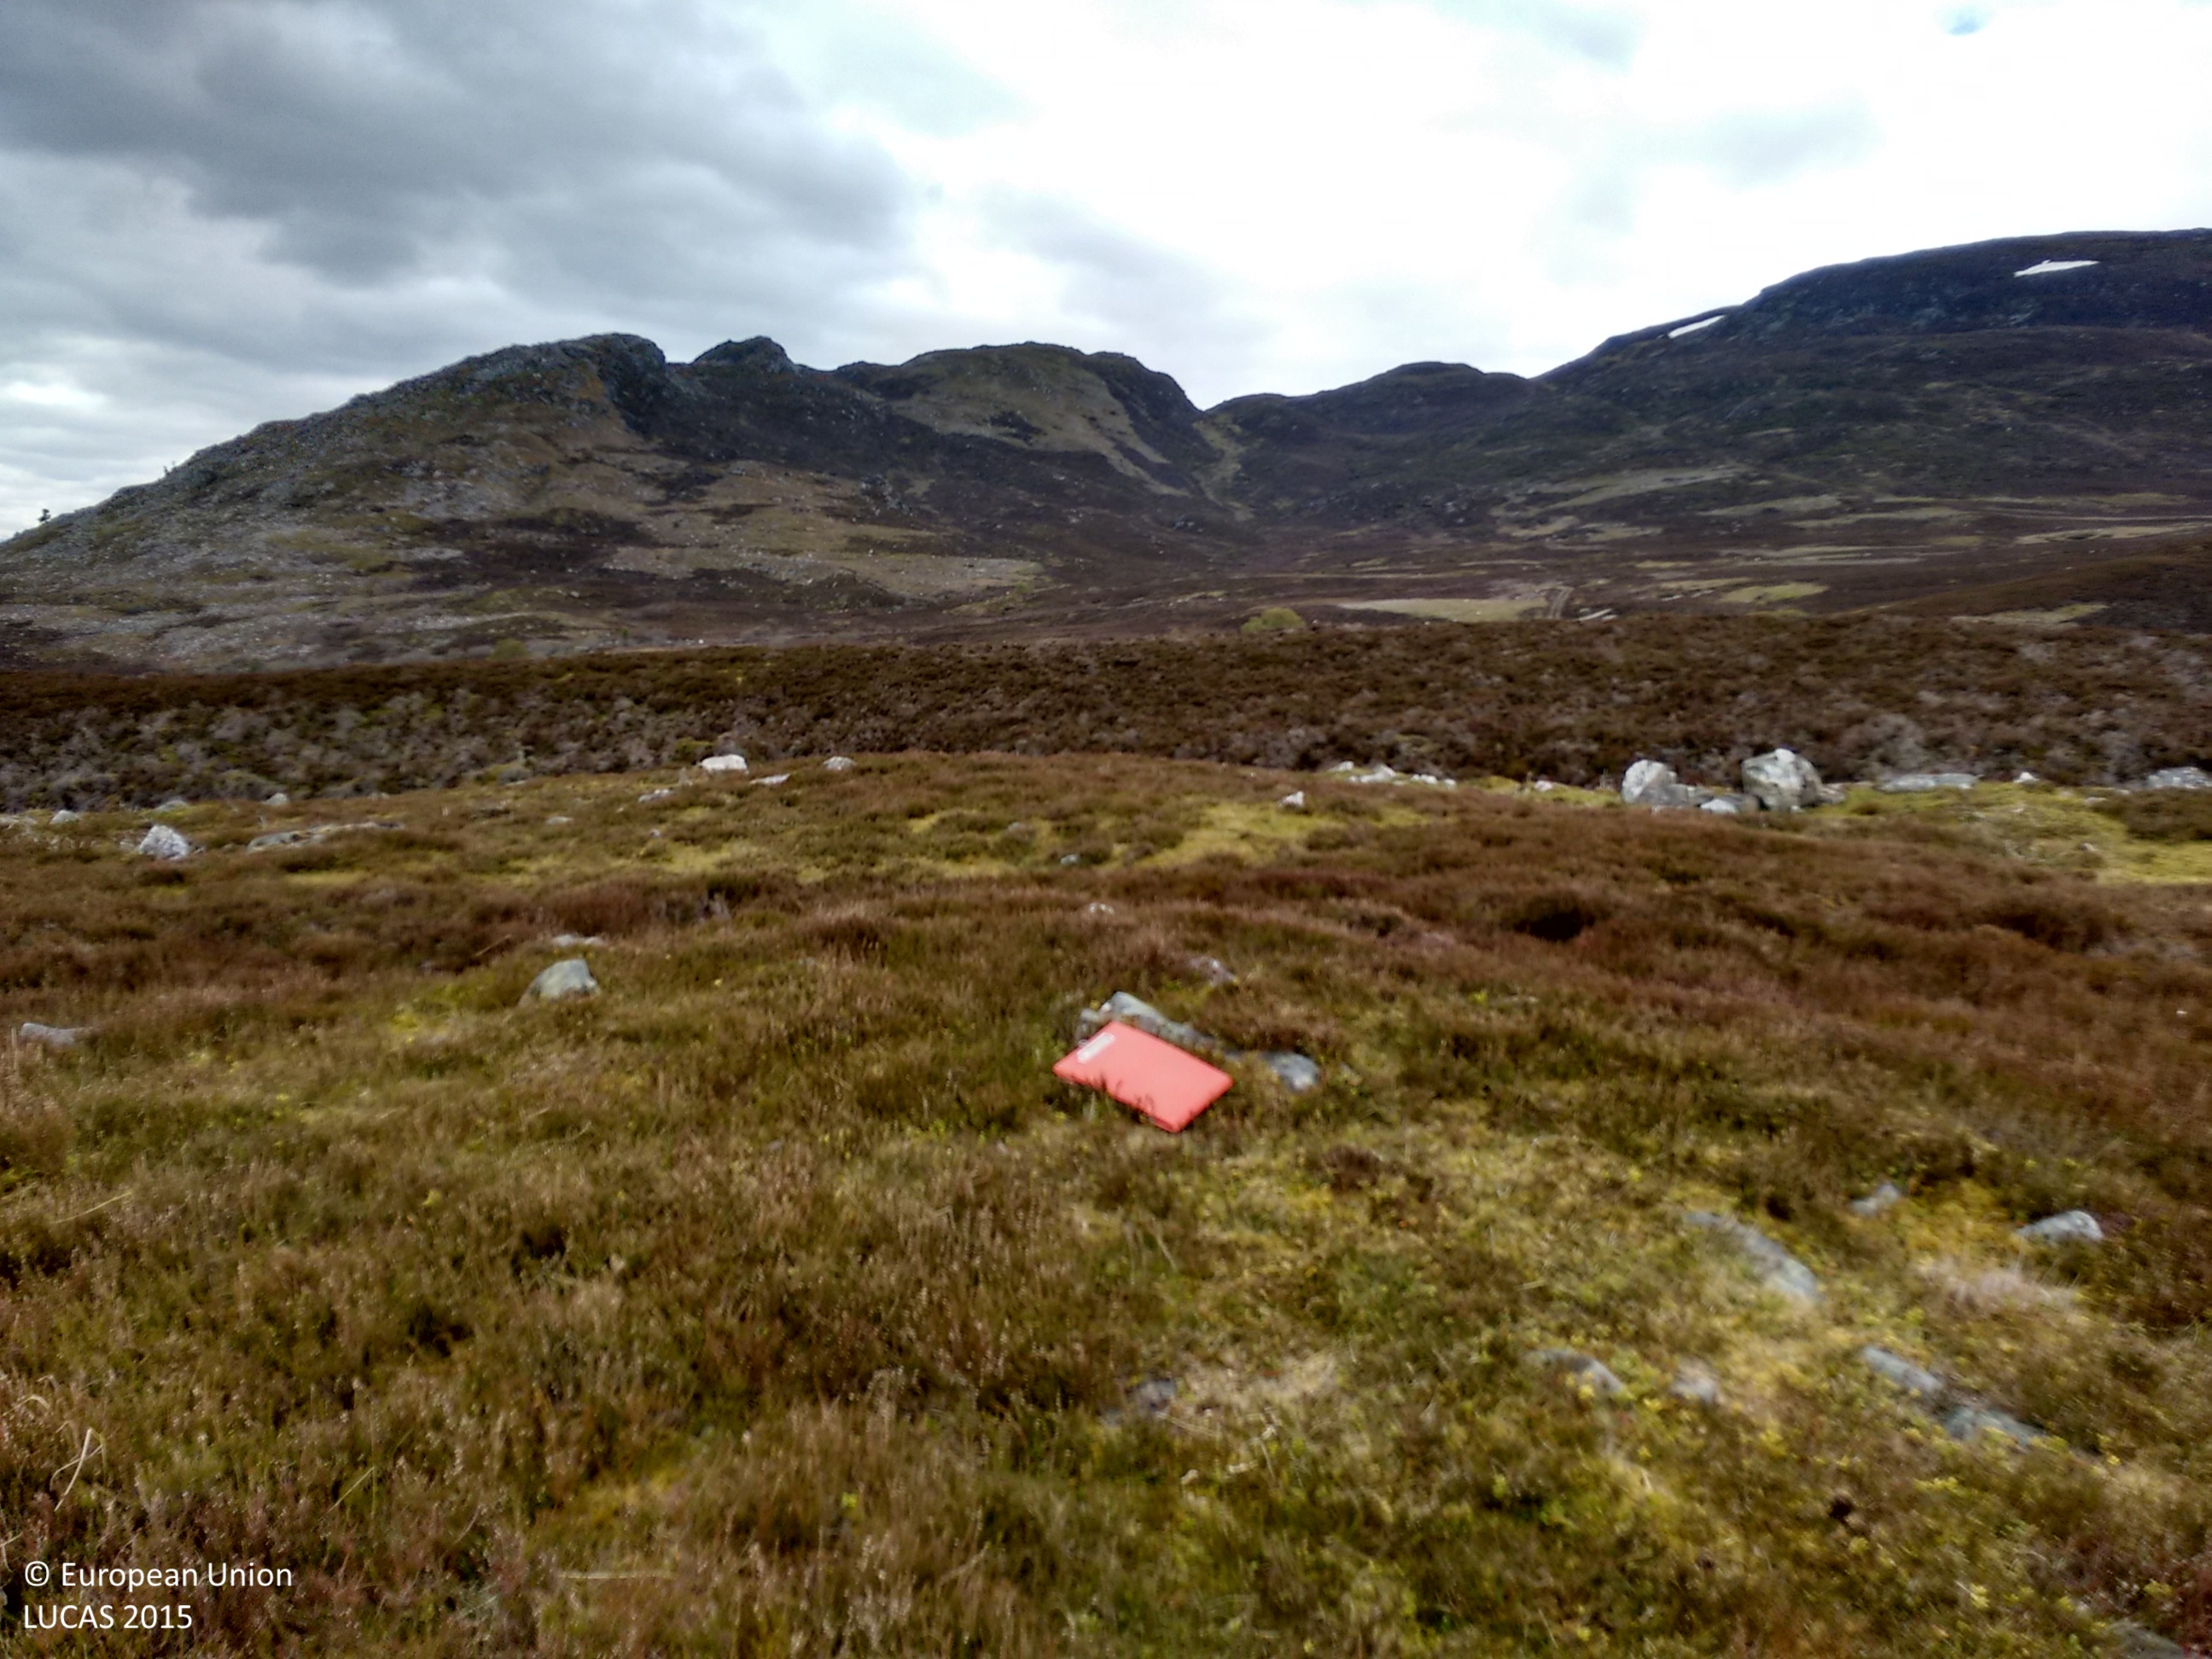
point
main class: Shrubland
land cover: Shrubland without tree cover
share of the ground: > 75 %
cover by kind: shrubs 90 %, lichens and mosses 5 %
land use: Agriculture (excluding fallow land and kitchen gardens)
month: June
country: GB
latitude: 57.1083
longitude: -4.0683
